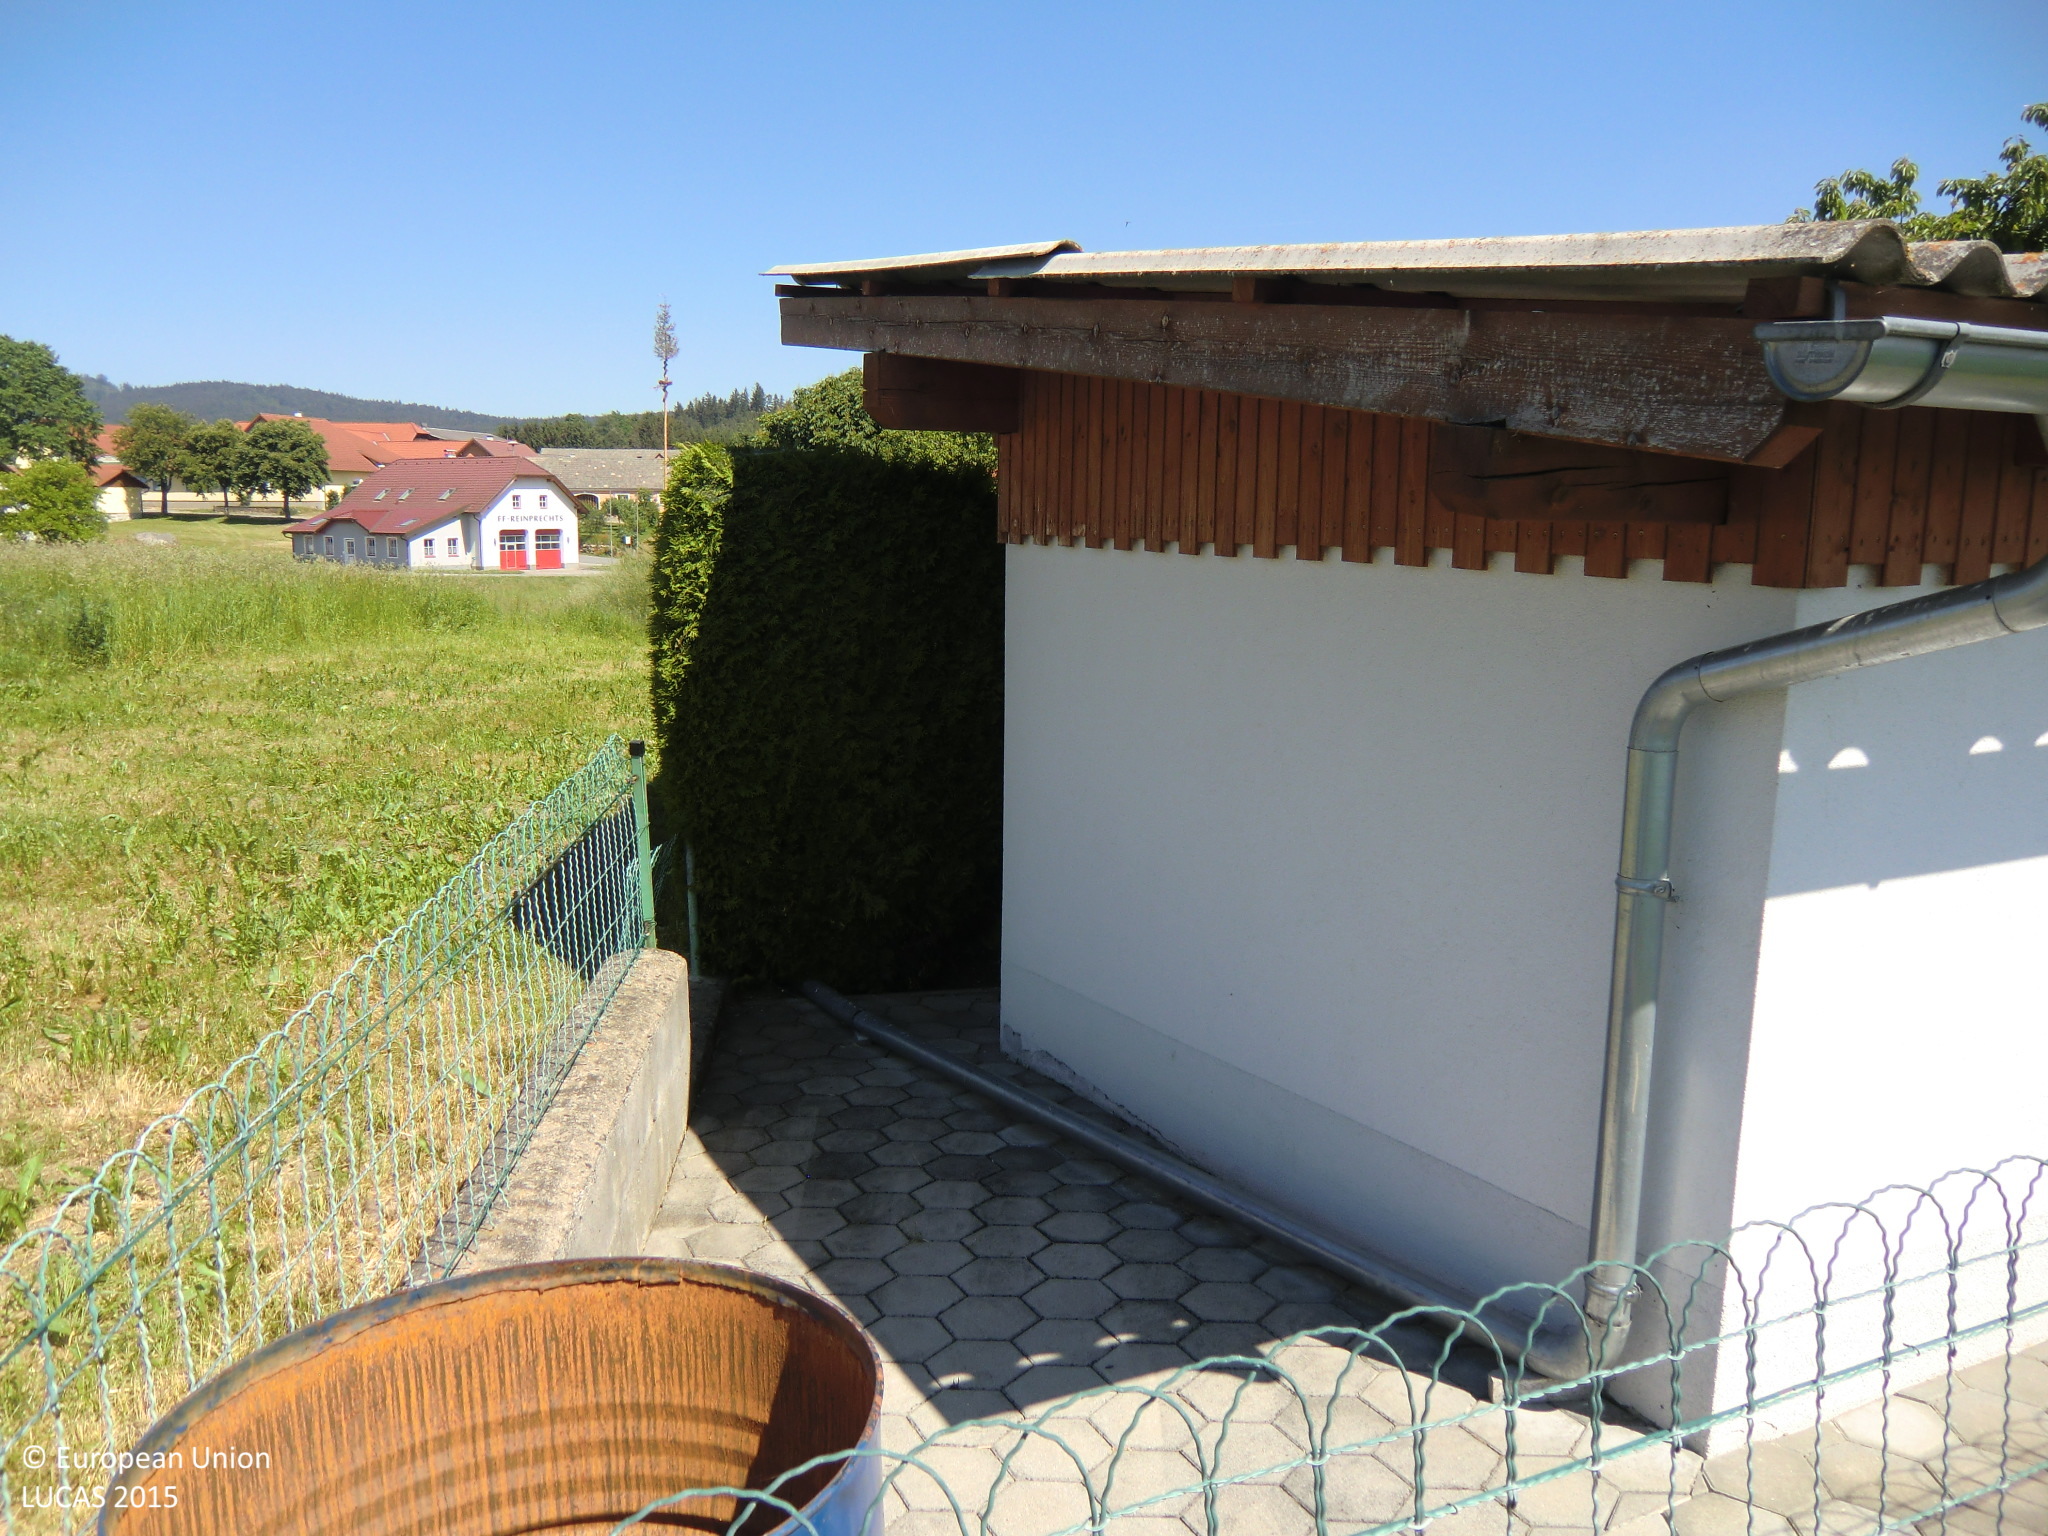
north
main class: Cropland
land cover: Barley
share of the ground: > 75 %
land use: Agriculture (excluding fallow land and kitchen gardens)
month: June
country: AT
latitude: 48.7115
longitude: 14.8533
